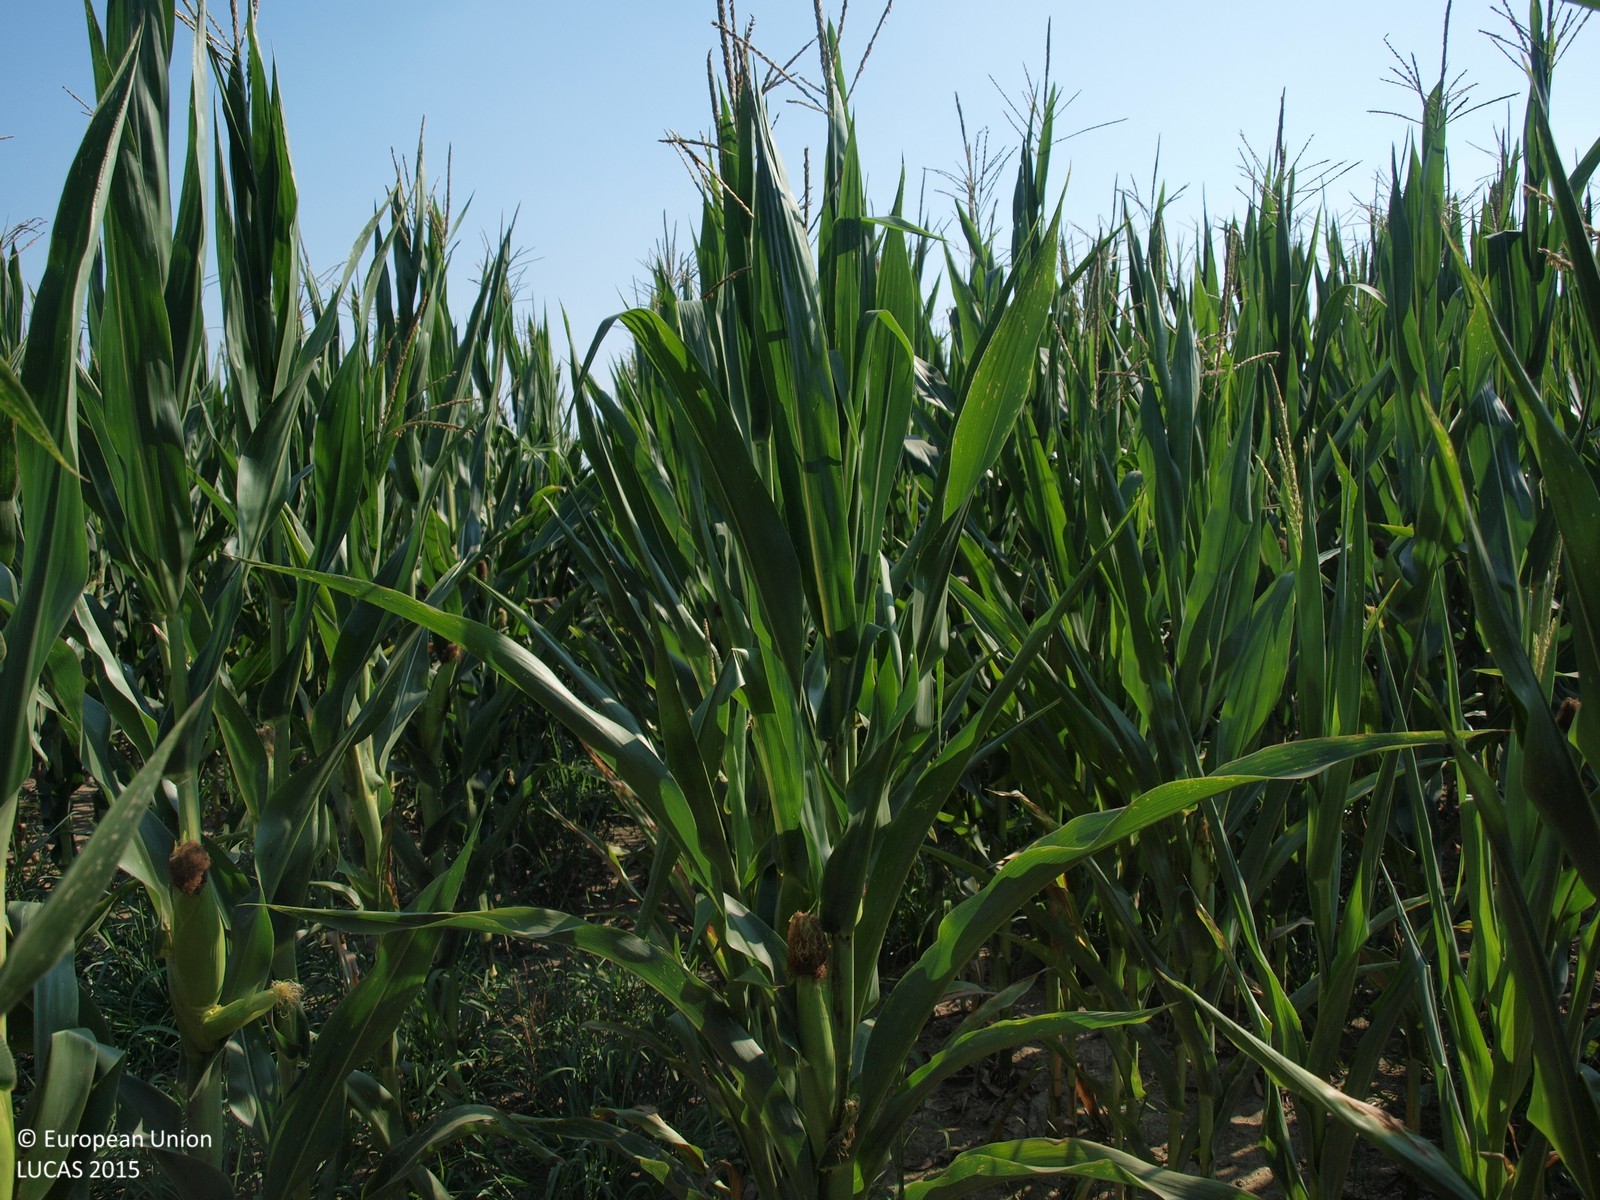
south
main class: Cropland
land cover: Maize
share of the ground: > 75 %
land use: Agriculture (excluding fallow land and kitchen gardens)
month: August
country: HR
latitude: 45.8641
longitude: 16.5042
